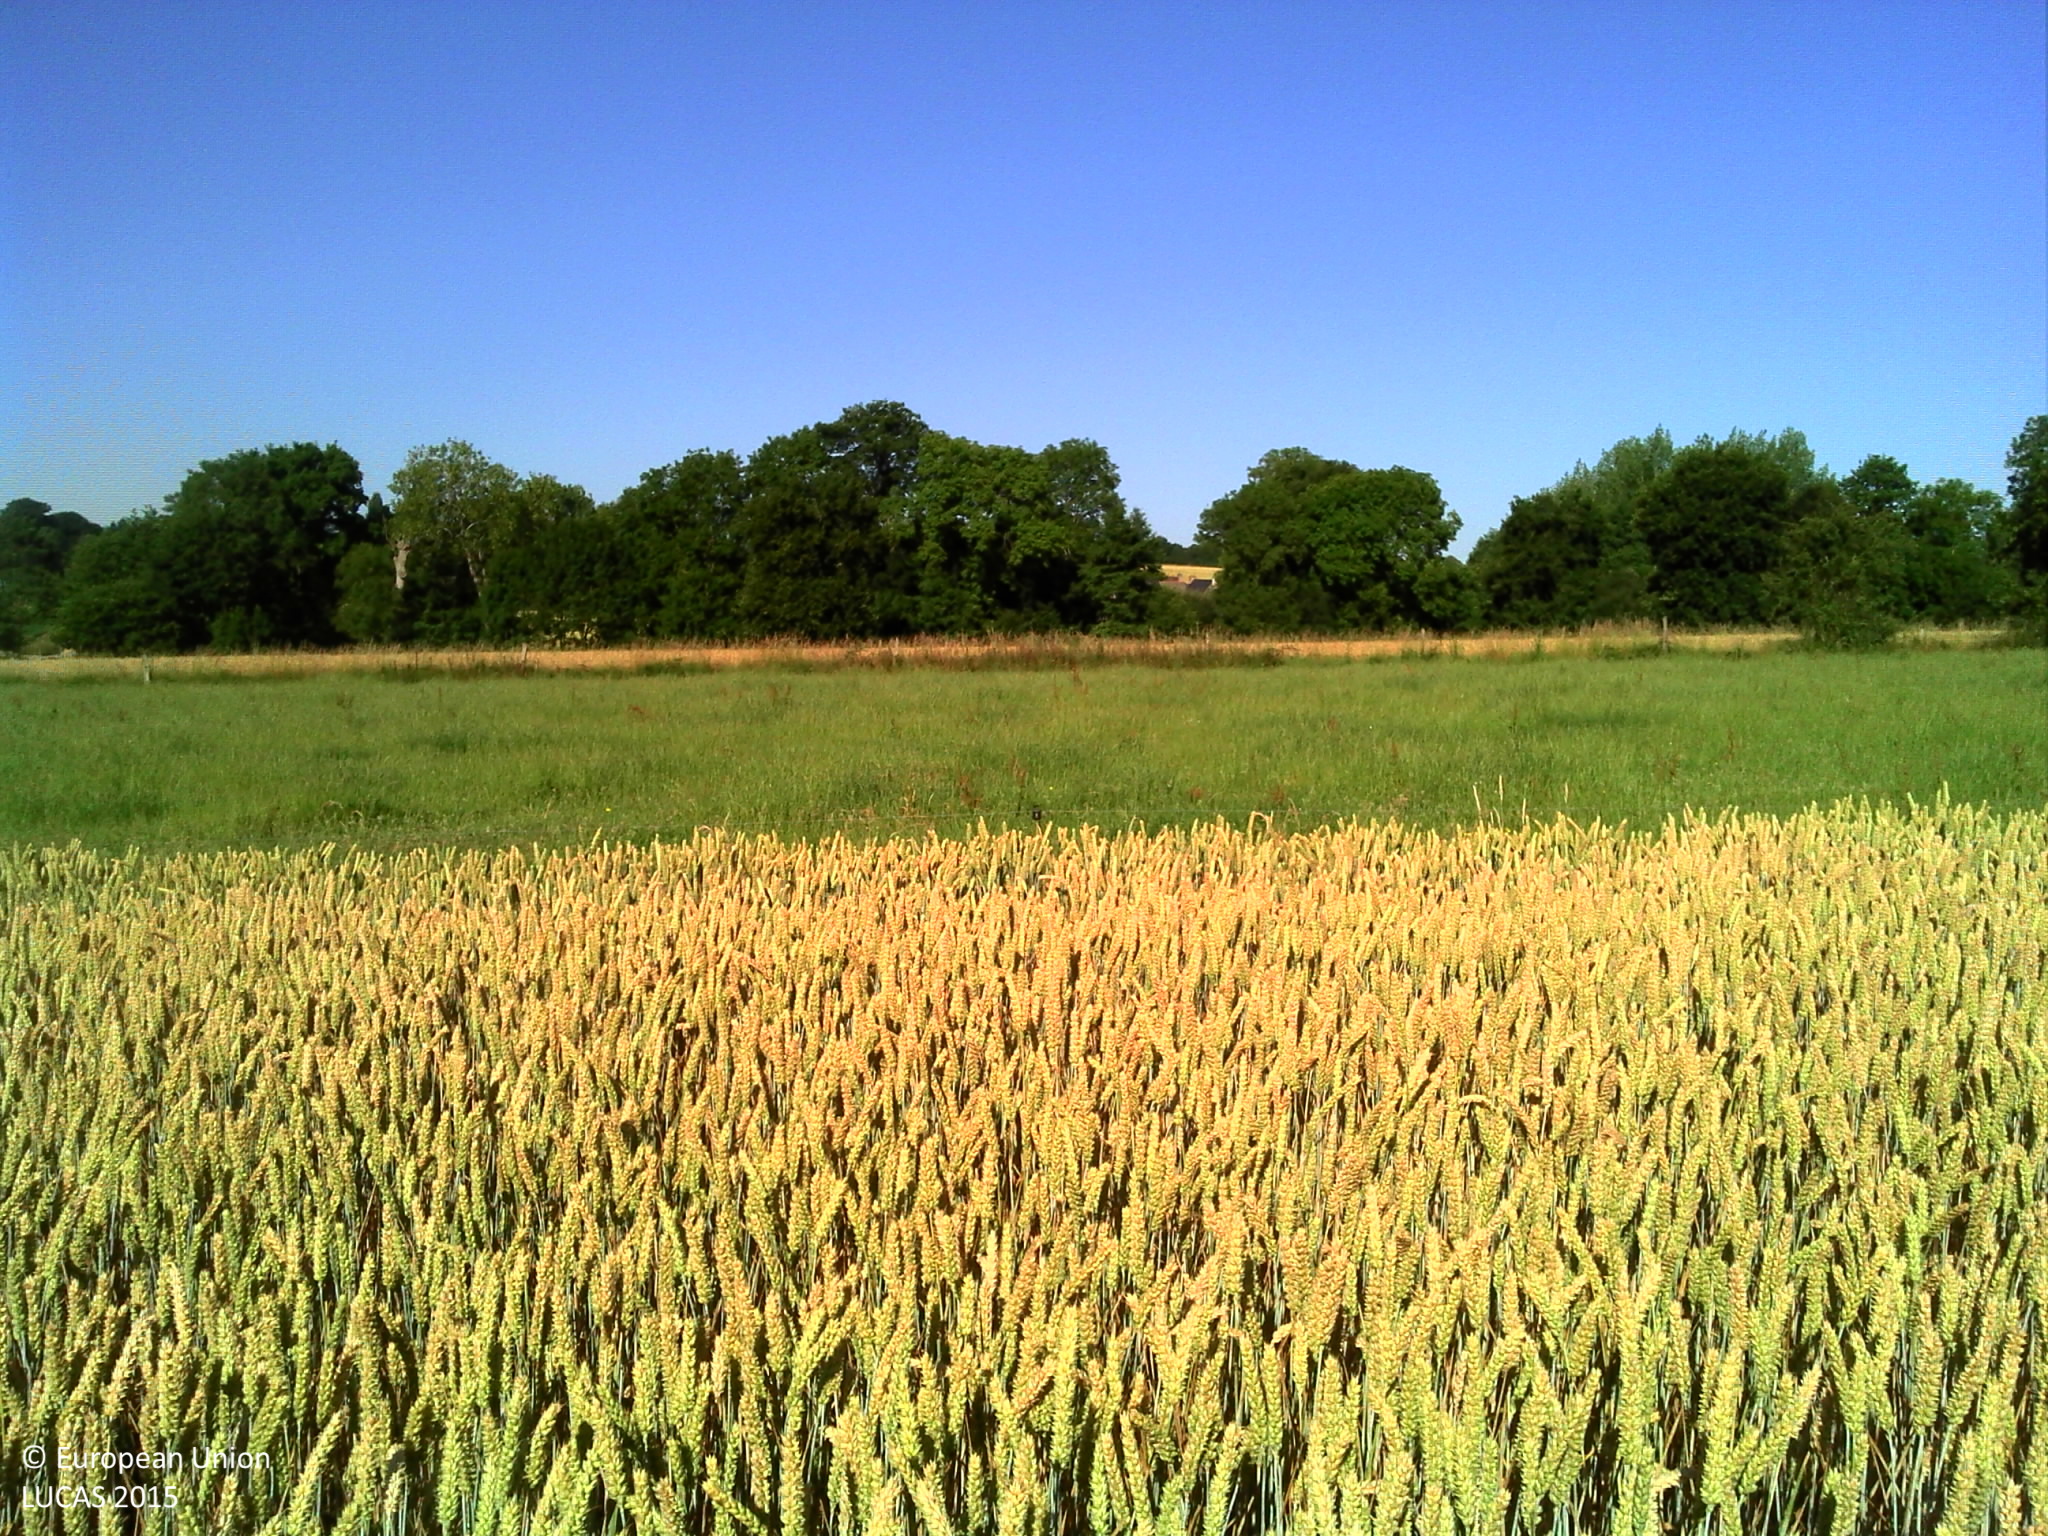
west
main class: Cropland
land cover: Common wheat
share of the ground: > 75 %
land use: Agriculture (excluding fallow land and kitchen gardens)
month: June
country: FR
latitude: 48.5414
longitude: -1.5473
